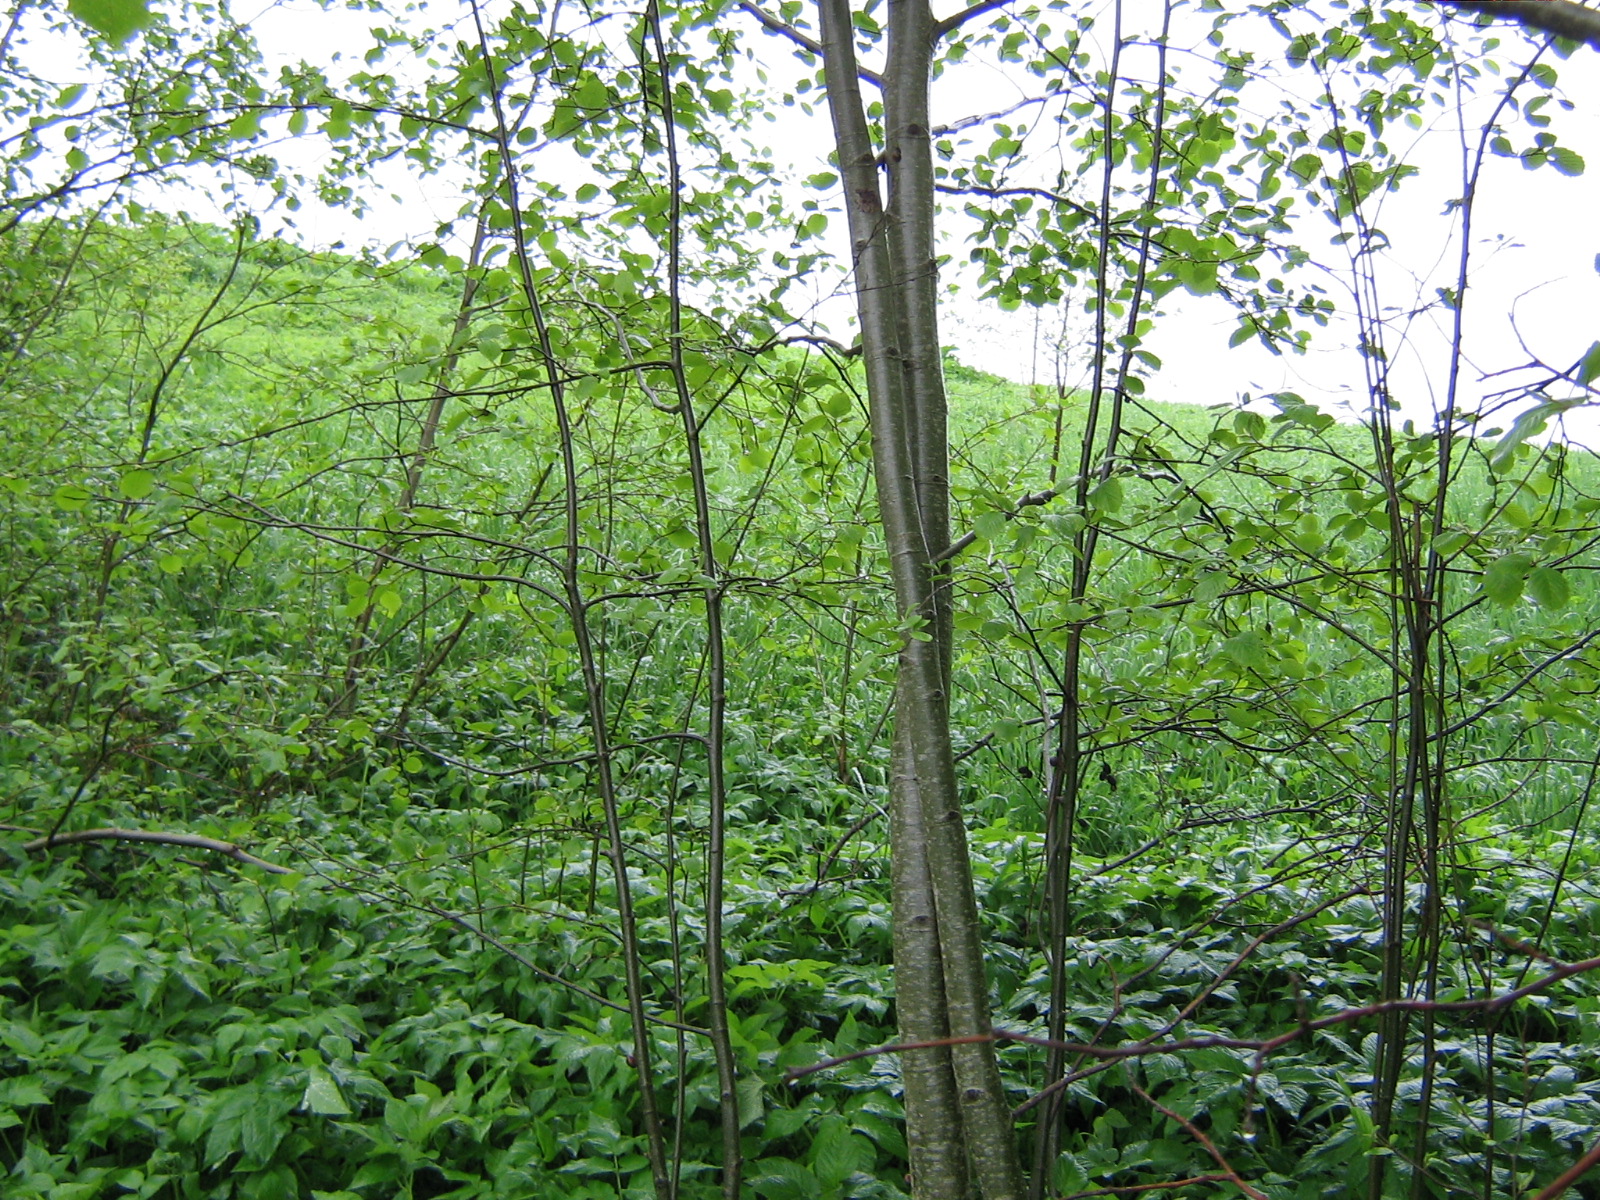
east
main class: Woodland
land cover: Broadleaved woodland
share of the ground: > 75 %
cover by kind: broadleaved forest trees 85 %, shrubs 15 %
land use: Semi-natural and natural areas not in use
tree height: > 5 m
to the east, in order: Broadleaved woodland; Grassland with sparse tree/shrub cover; Grassland without tree/shrub cover; Electric lines; Grassland without tree/shrub cover; Ditches and canals; Grass margins; Paved roads, cycling and walking lanes; Grass margins; Ditches and canals; Grassland without tree/shrub cover
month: May
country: LV
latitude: 57.2214
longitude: 25.9443
